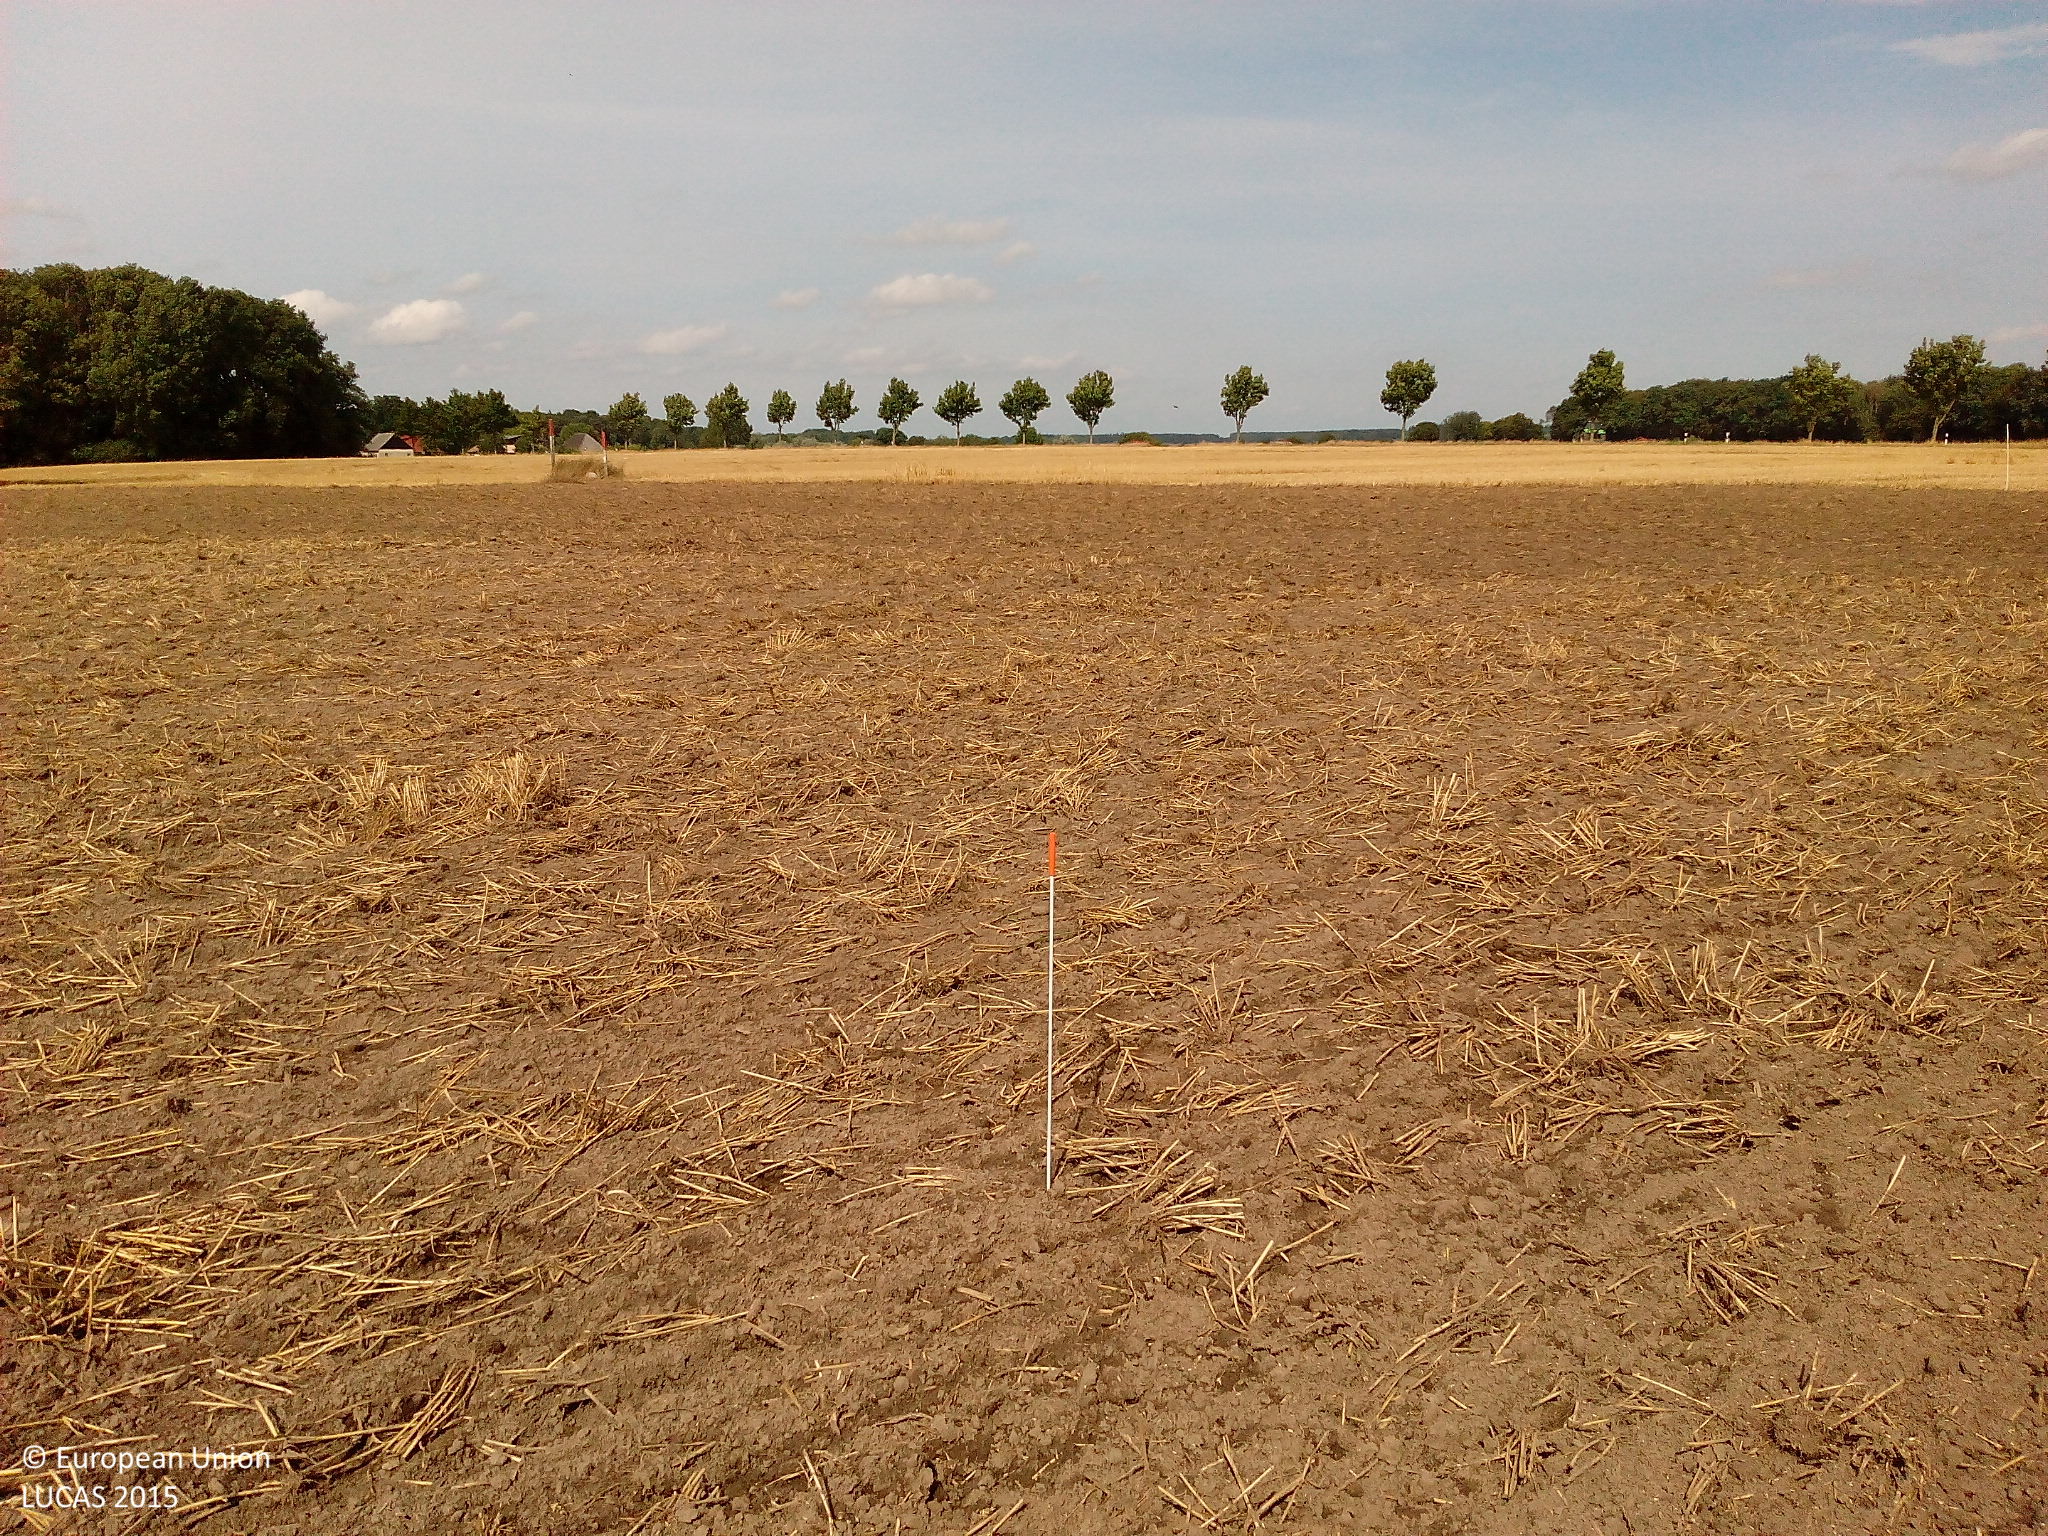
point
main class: Cropland
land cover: Common wheat
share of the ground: < 10 %
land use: Agriculture (excluding fallow land and kitchen gardens)
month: August
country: DE
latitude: 53.9487
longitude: 12.6351
